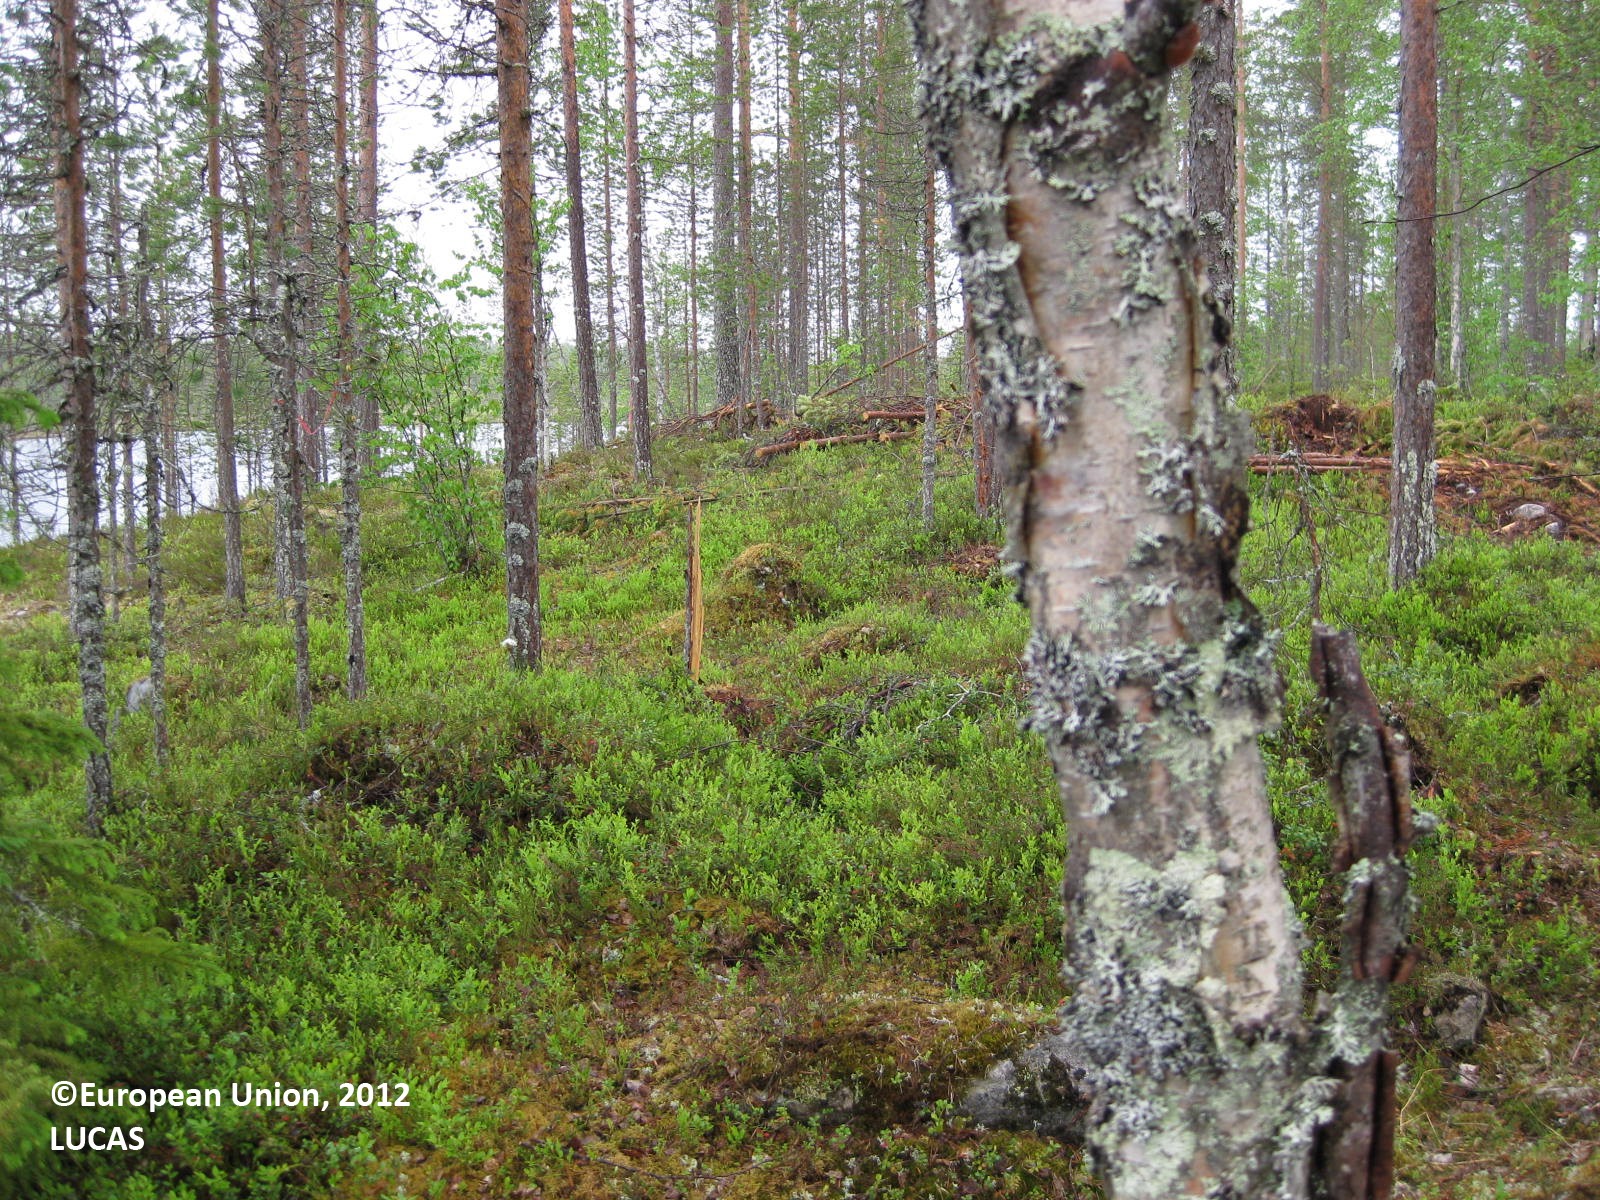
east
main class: Woodland
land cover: Pine dominated mixed woodland
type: boreal forest
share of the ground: 50 - 75 %
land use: Forestry
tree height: > 5 m
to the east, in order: Pine dominated mixed woodland; Pine dominated coniferous woodland; Inland water bodies; Pine dominated coniferous woodland; Peatbogs; Pine dominated coniferous woodland
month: June
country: FI
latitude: 65.1454
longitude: 29.2790
